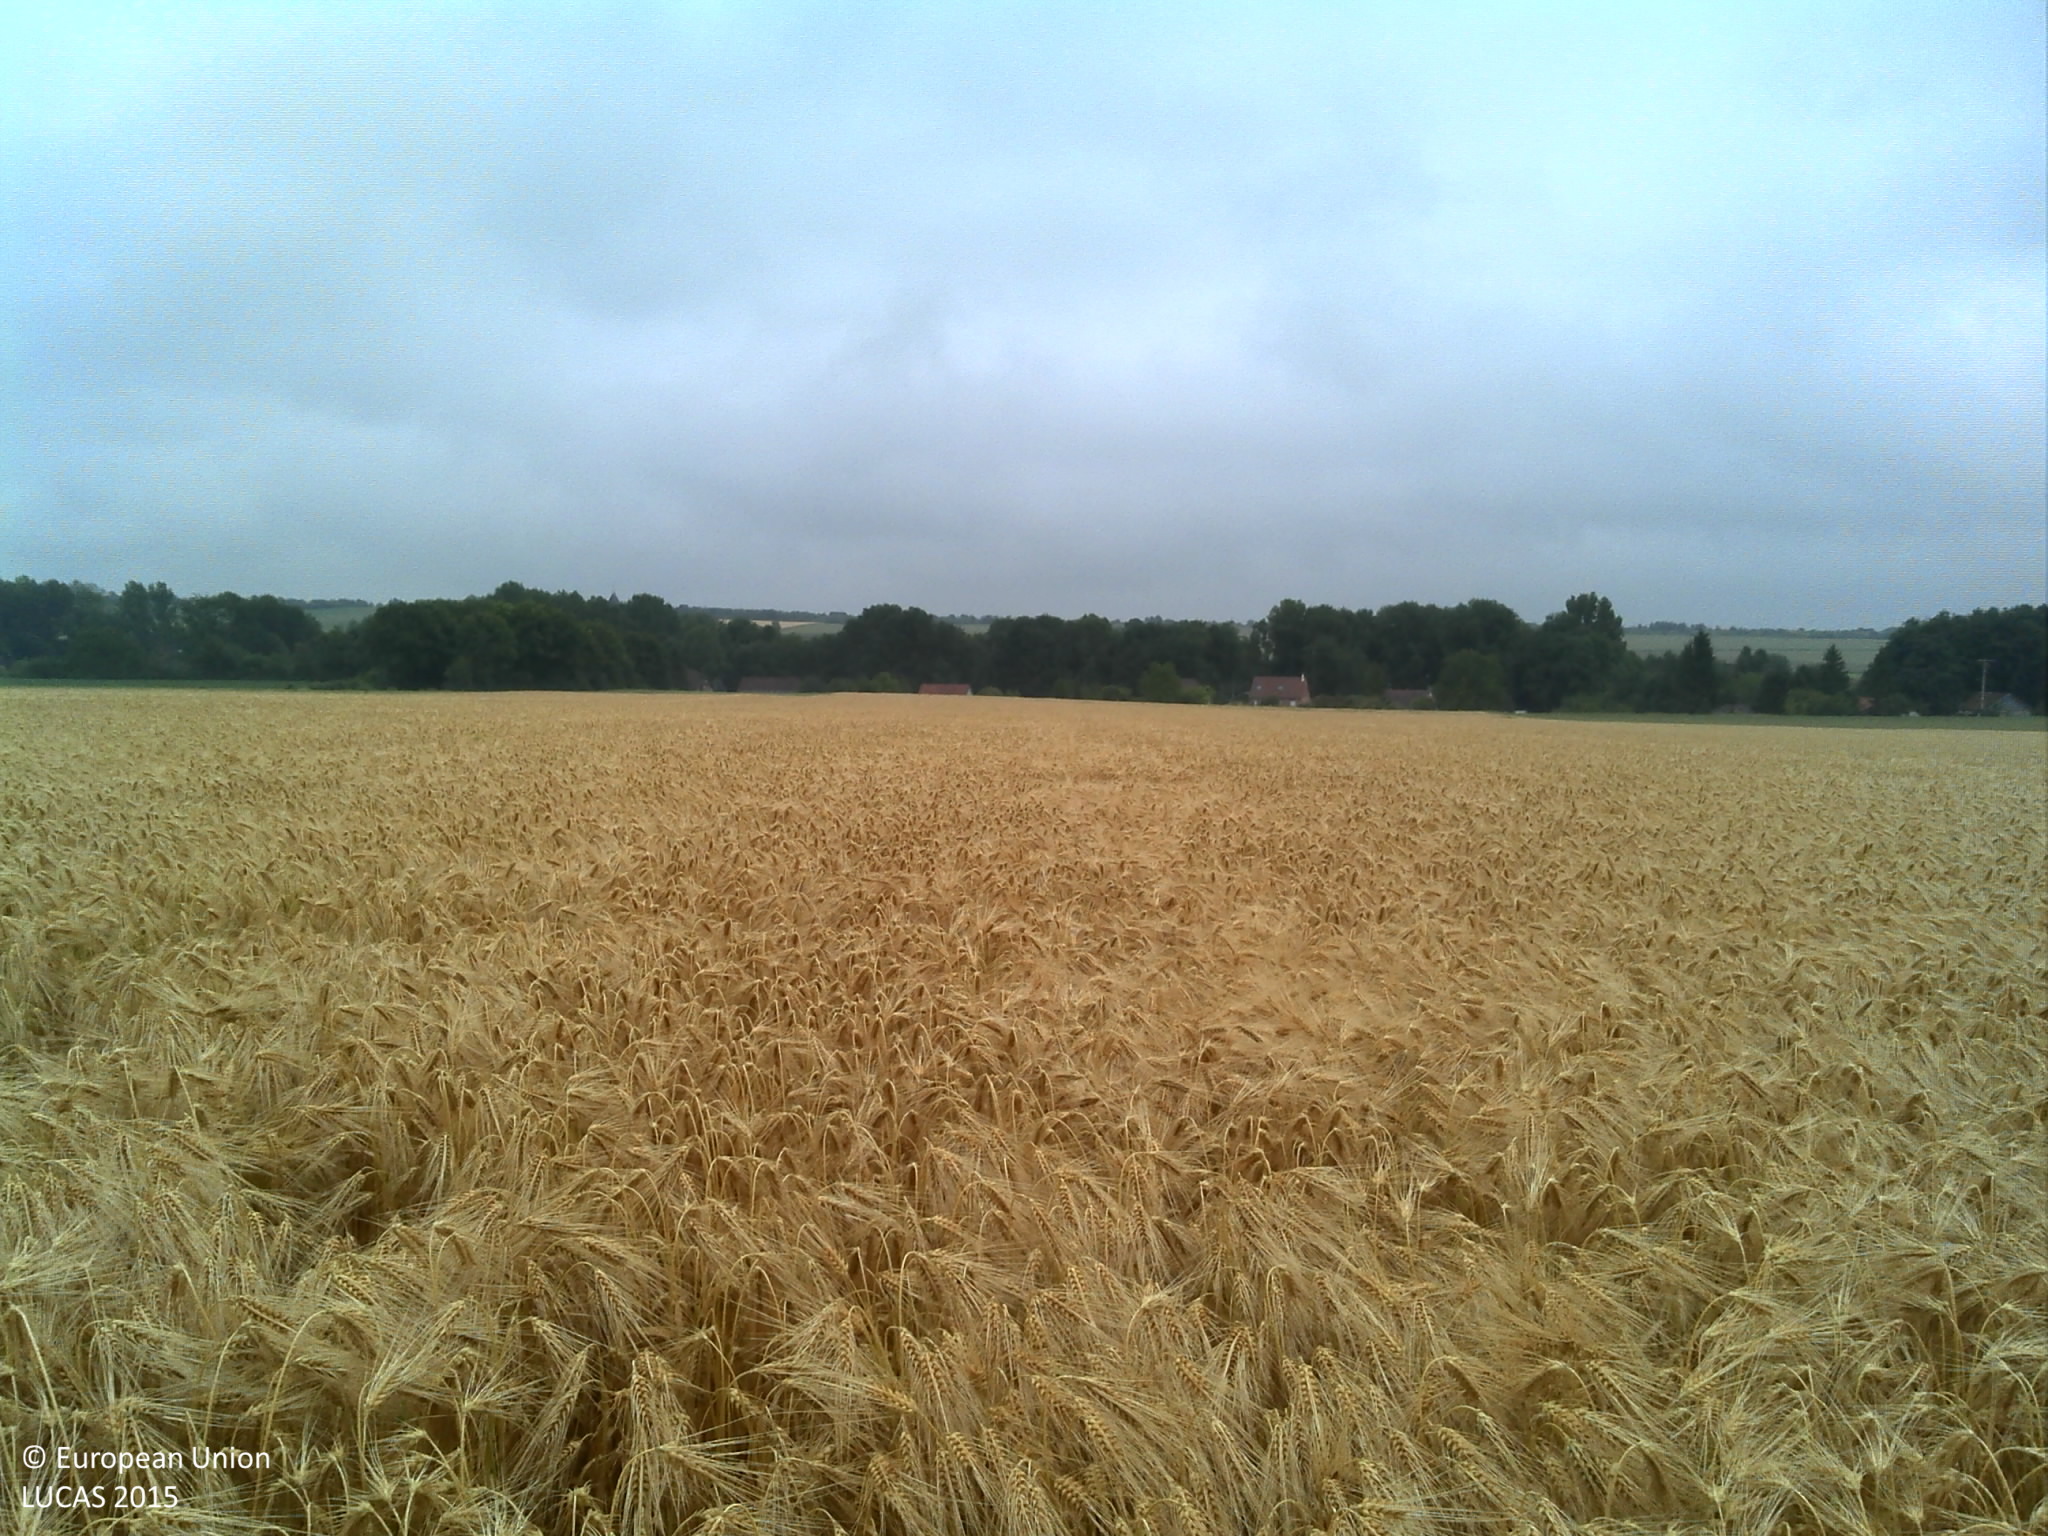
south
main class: Cropland
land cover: Common wheat
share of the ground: > 75 %
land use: Agriculture (excluding fallow land and kitchen gardens)
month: June
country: FR
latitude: 48.6868
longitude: 4.2504
